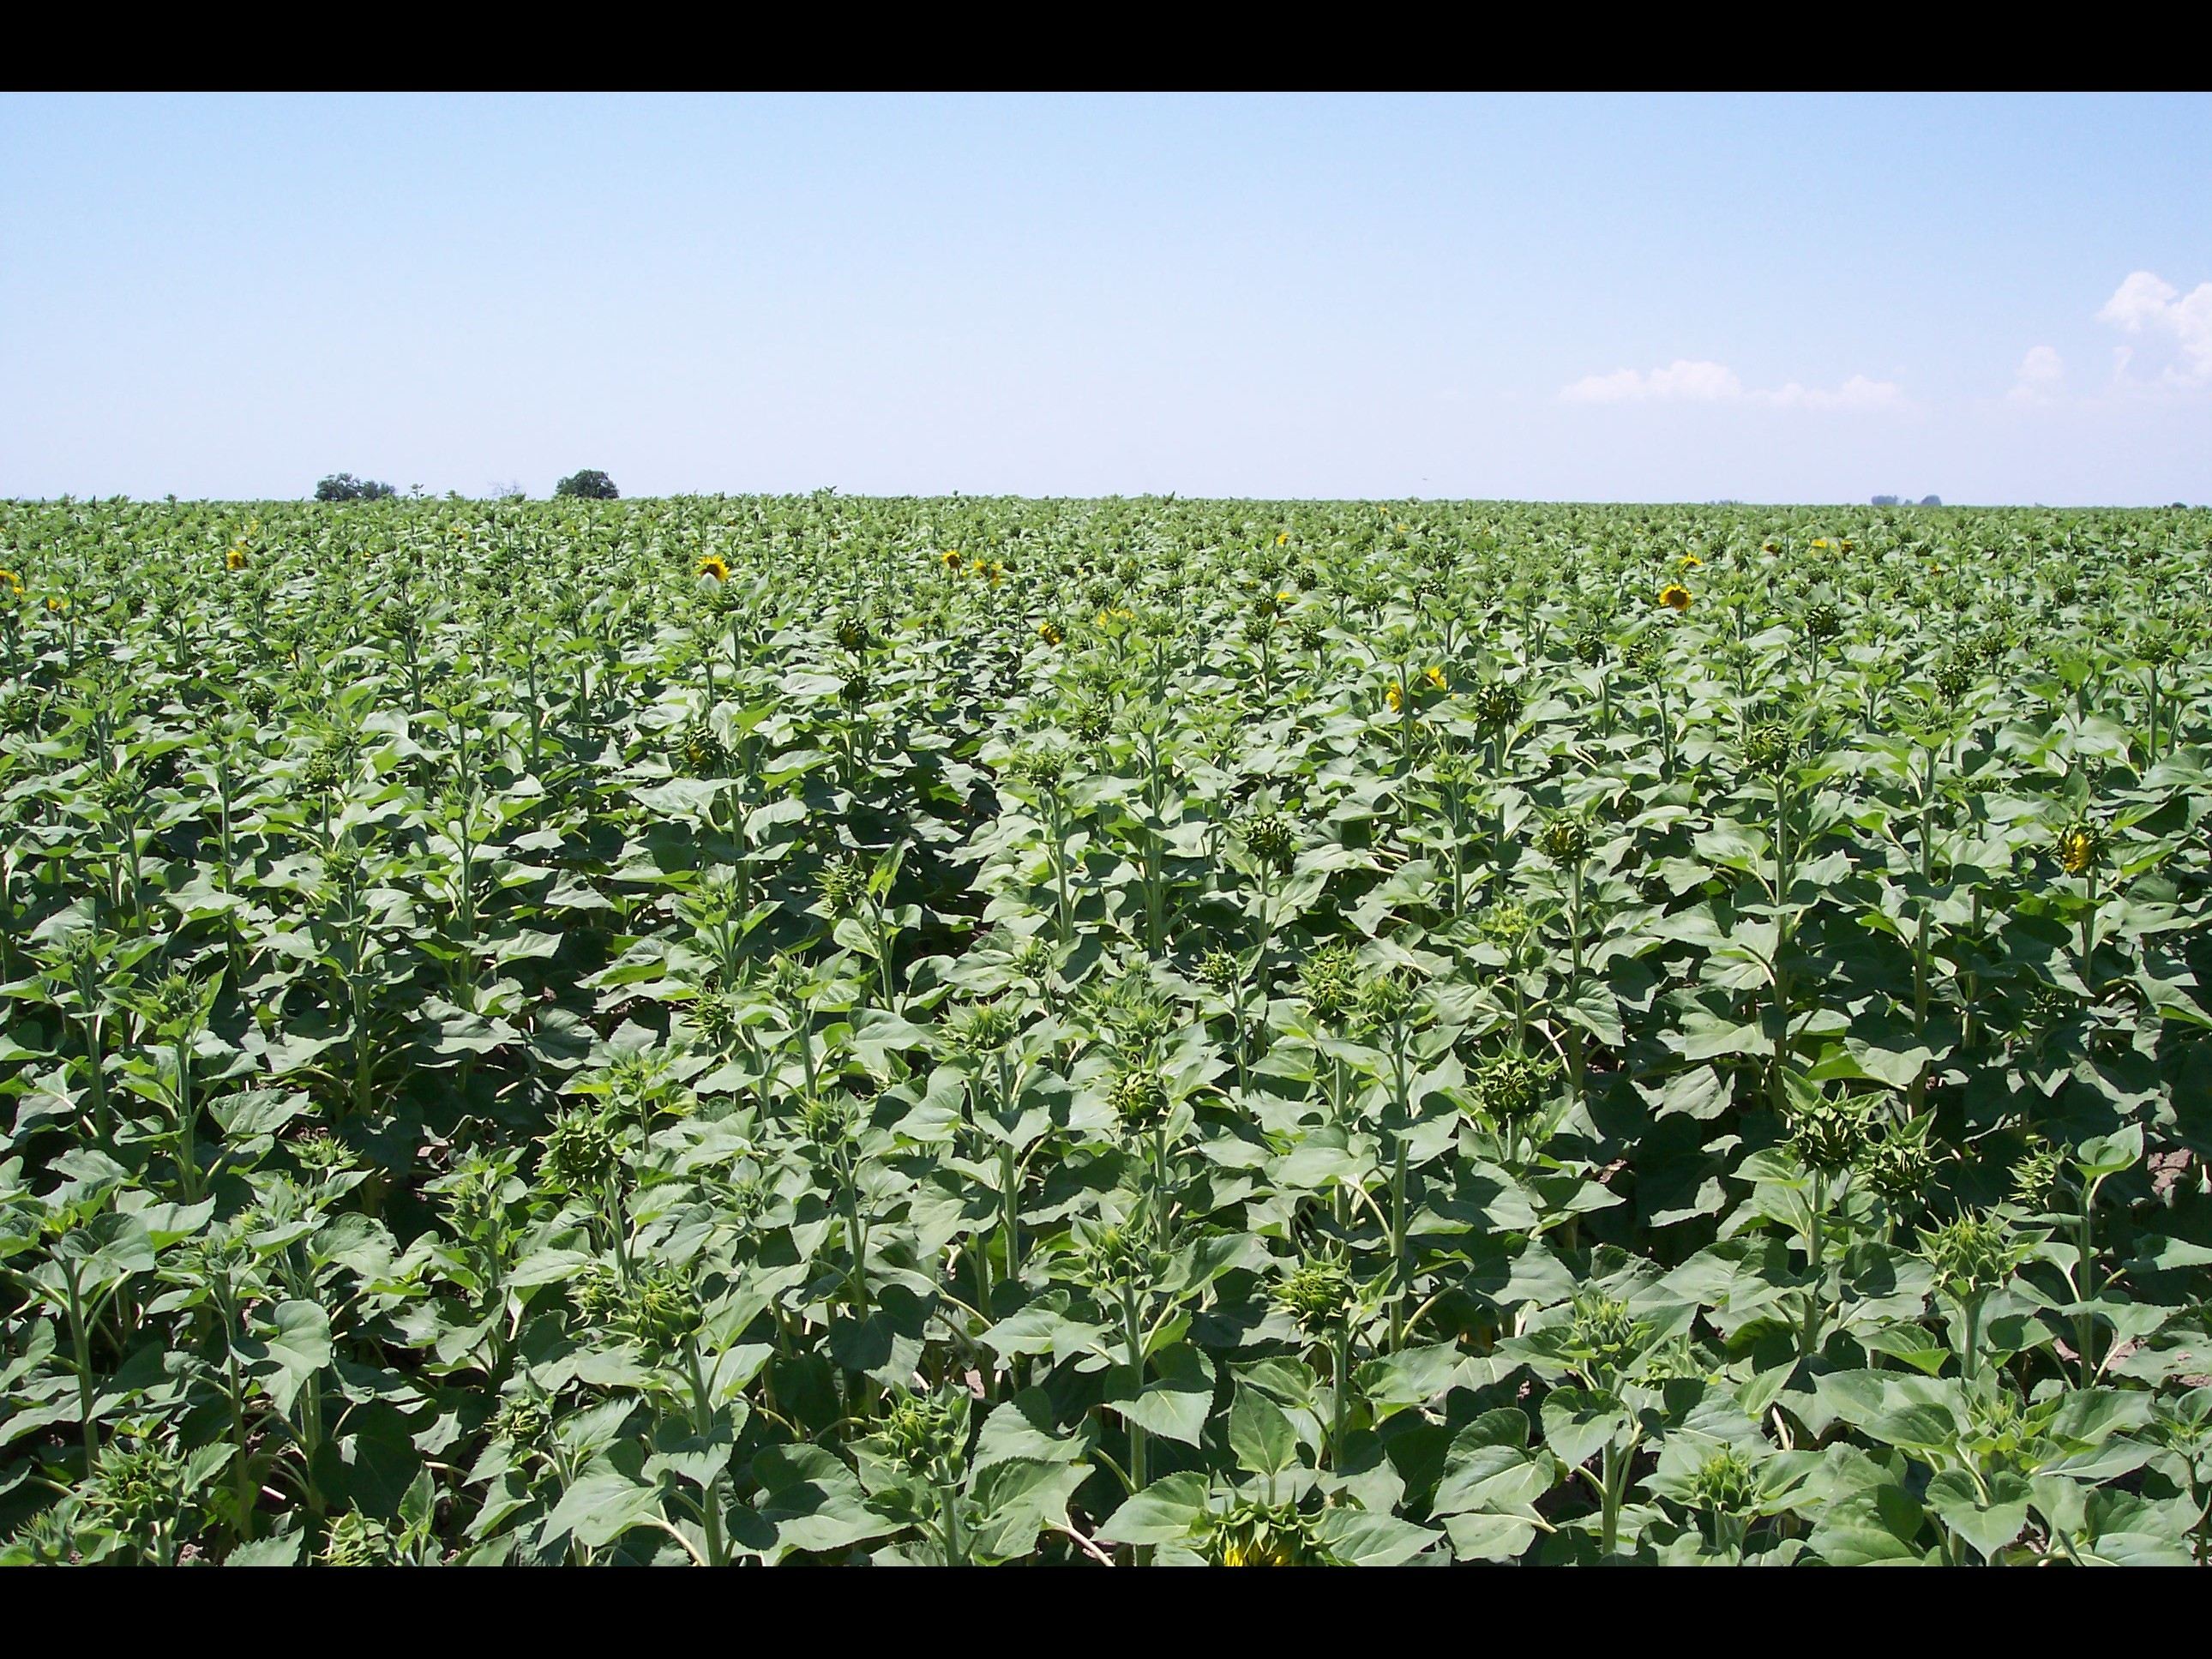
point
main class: Cropland
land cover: Sunflower
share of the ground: > 75 %
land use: Agriculture (excluding fallow land and kitchen gardens)
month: May
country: ES
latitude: 37.1861
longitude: -6.0502
